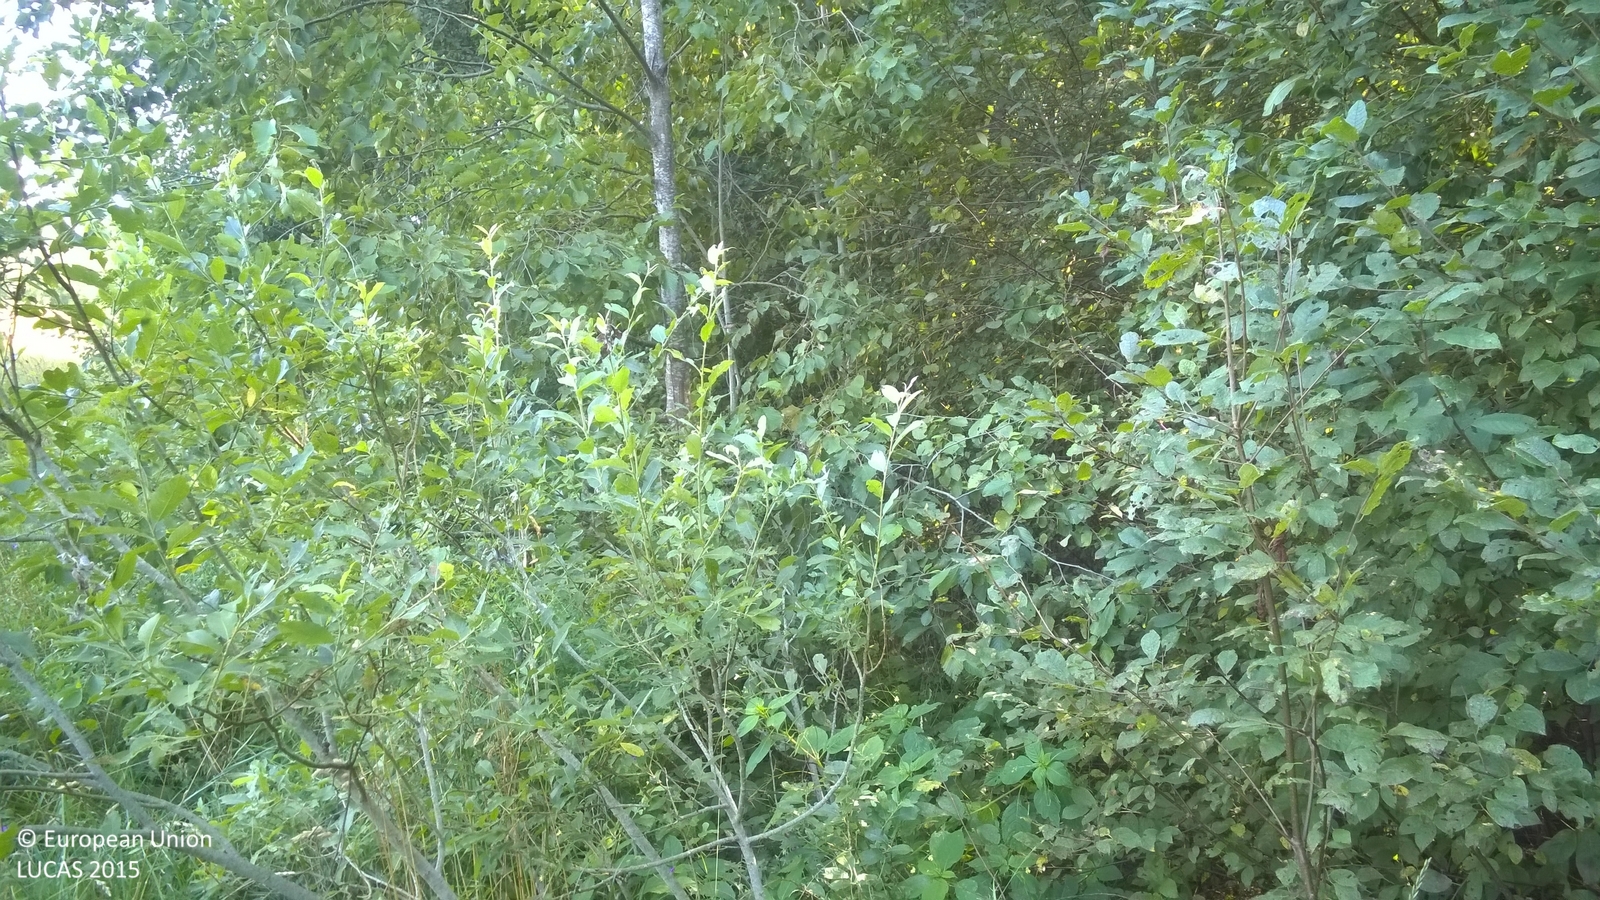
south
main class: Woodland
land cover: Broadleaved woodland
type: non-riverine alder, birch or aspen forest
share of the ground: > 75 %
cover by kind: broadleaved forest trees 90 %, shrubs 5 %, herbaceous plants 5 %
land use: Forestry
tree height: > 5 m
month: August
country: LV
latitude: 57.2899
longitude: 25.5309
